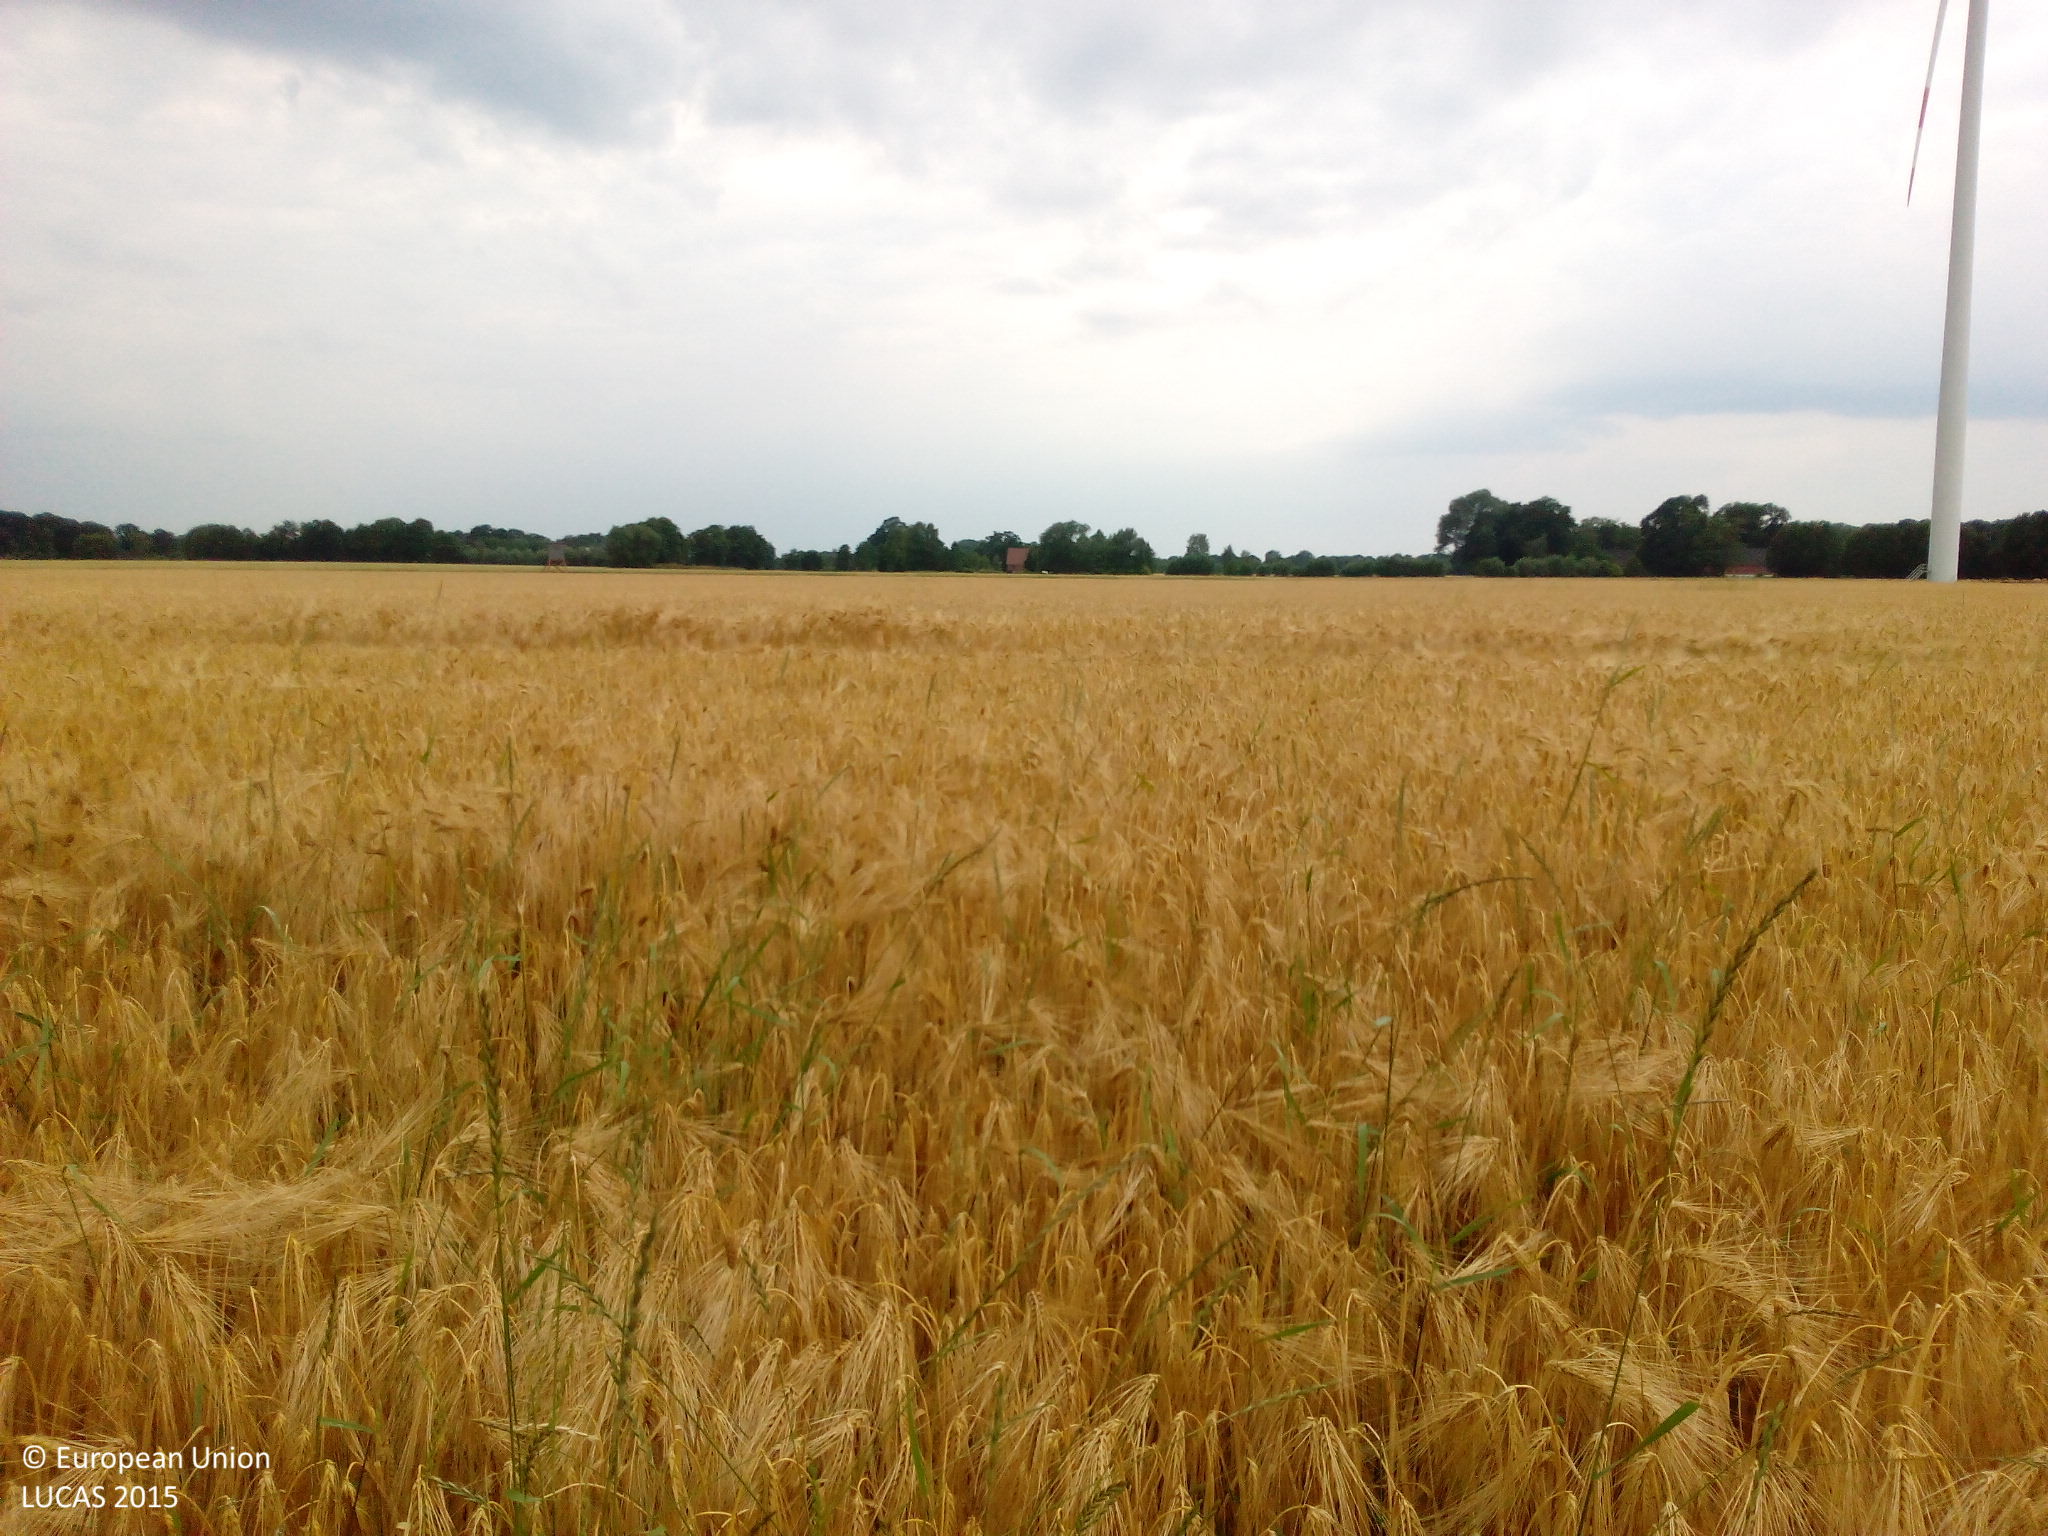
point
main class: Cropland
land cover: Barley
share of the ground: > 75 %
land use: Agriculture (excluding fallow land and kitchen gardens)
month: July
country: DE
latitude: 51.9186
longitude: 8.5028
